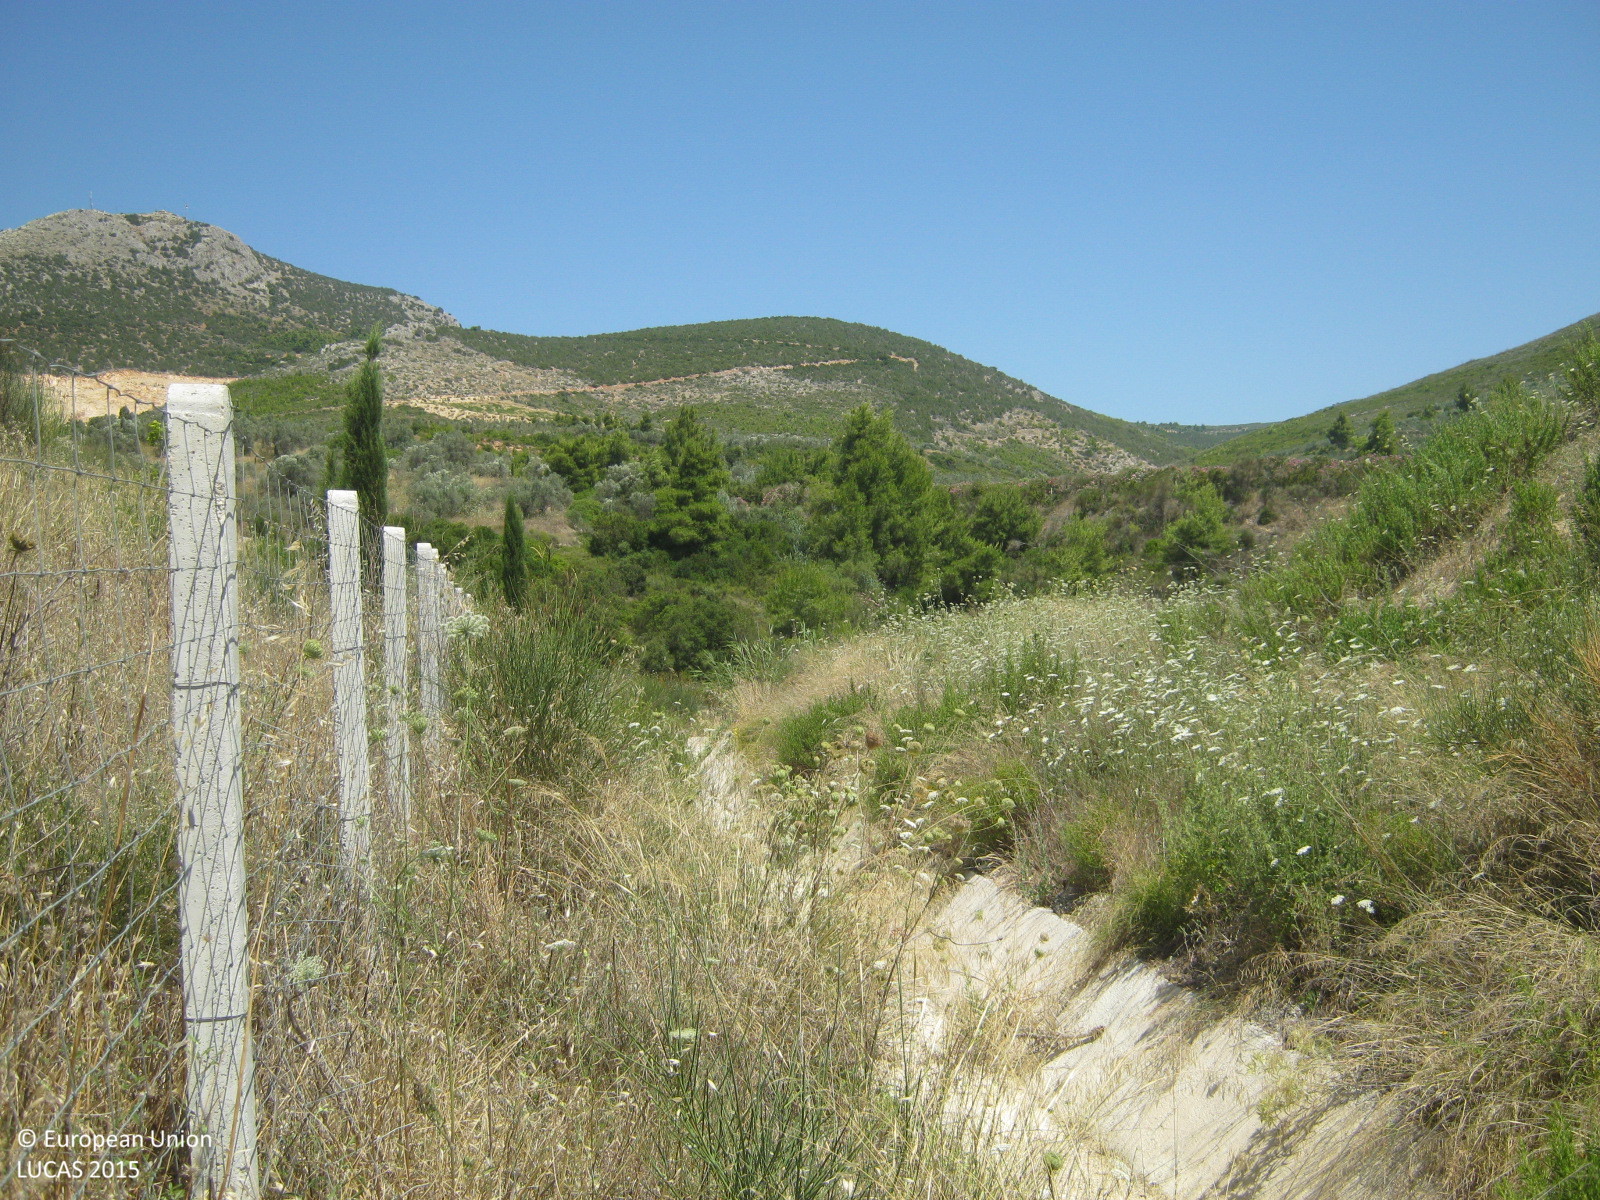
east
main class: Grassland
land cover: Grassland with sparse tree/shrub cover
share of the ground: > 75 %
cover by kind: herbaceous plants 80 %, unconsolidated bare surface 10 %, broadleaved forest trees 5 %, shrubs 5 %
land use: Semi-natural and natural areas not in use
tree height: < 5 m
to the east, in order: Grassland with sparse tree/shrub cover; Ditches and canals; Spontaneously vegetated surfaces; Shrubland with sparse tree cover; Pine dominated coniferous woodland; Tracks; Pine dominated coniferous woodland; Paved roads, cycling and walking lanes
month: July
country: GR
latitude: 37.8472
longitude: 22.8231
